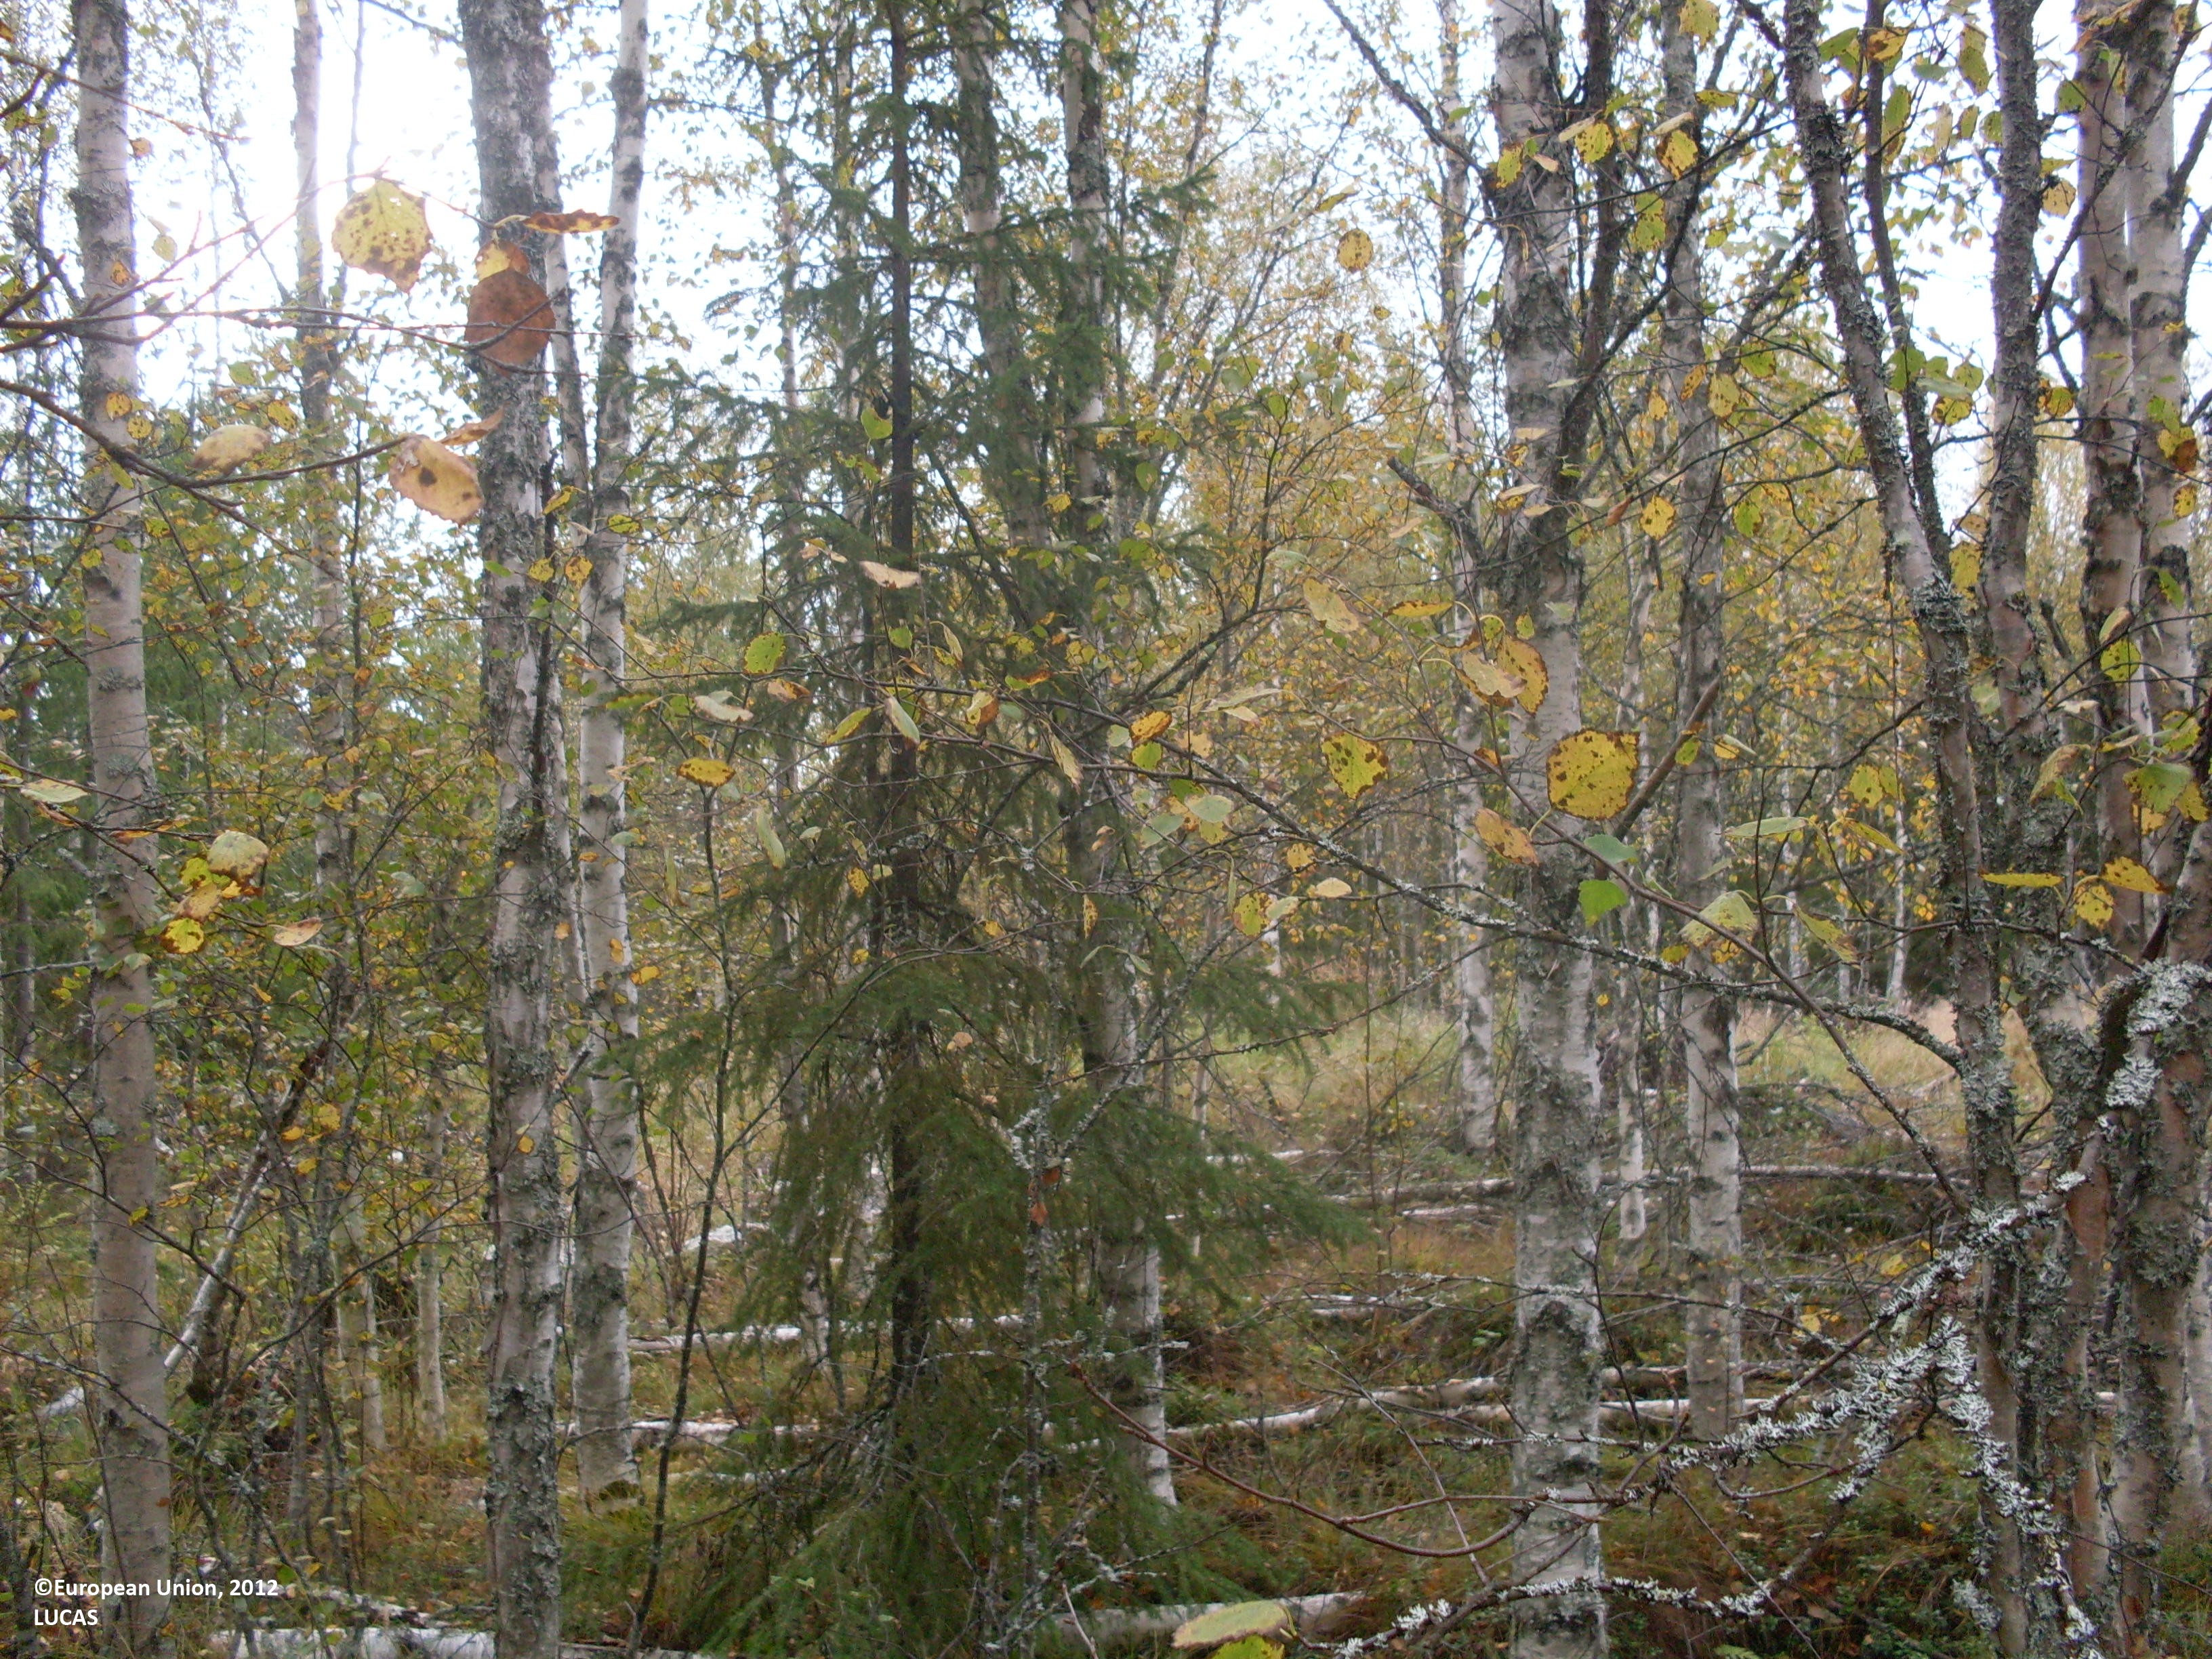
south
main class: Woodland
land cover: Other mixed woodland
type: boreal forest
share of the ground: > 75 %
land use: Forestry
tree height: > 5 m
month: September
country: FI
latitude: 63.9928
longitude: 29.4959
